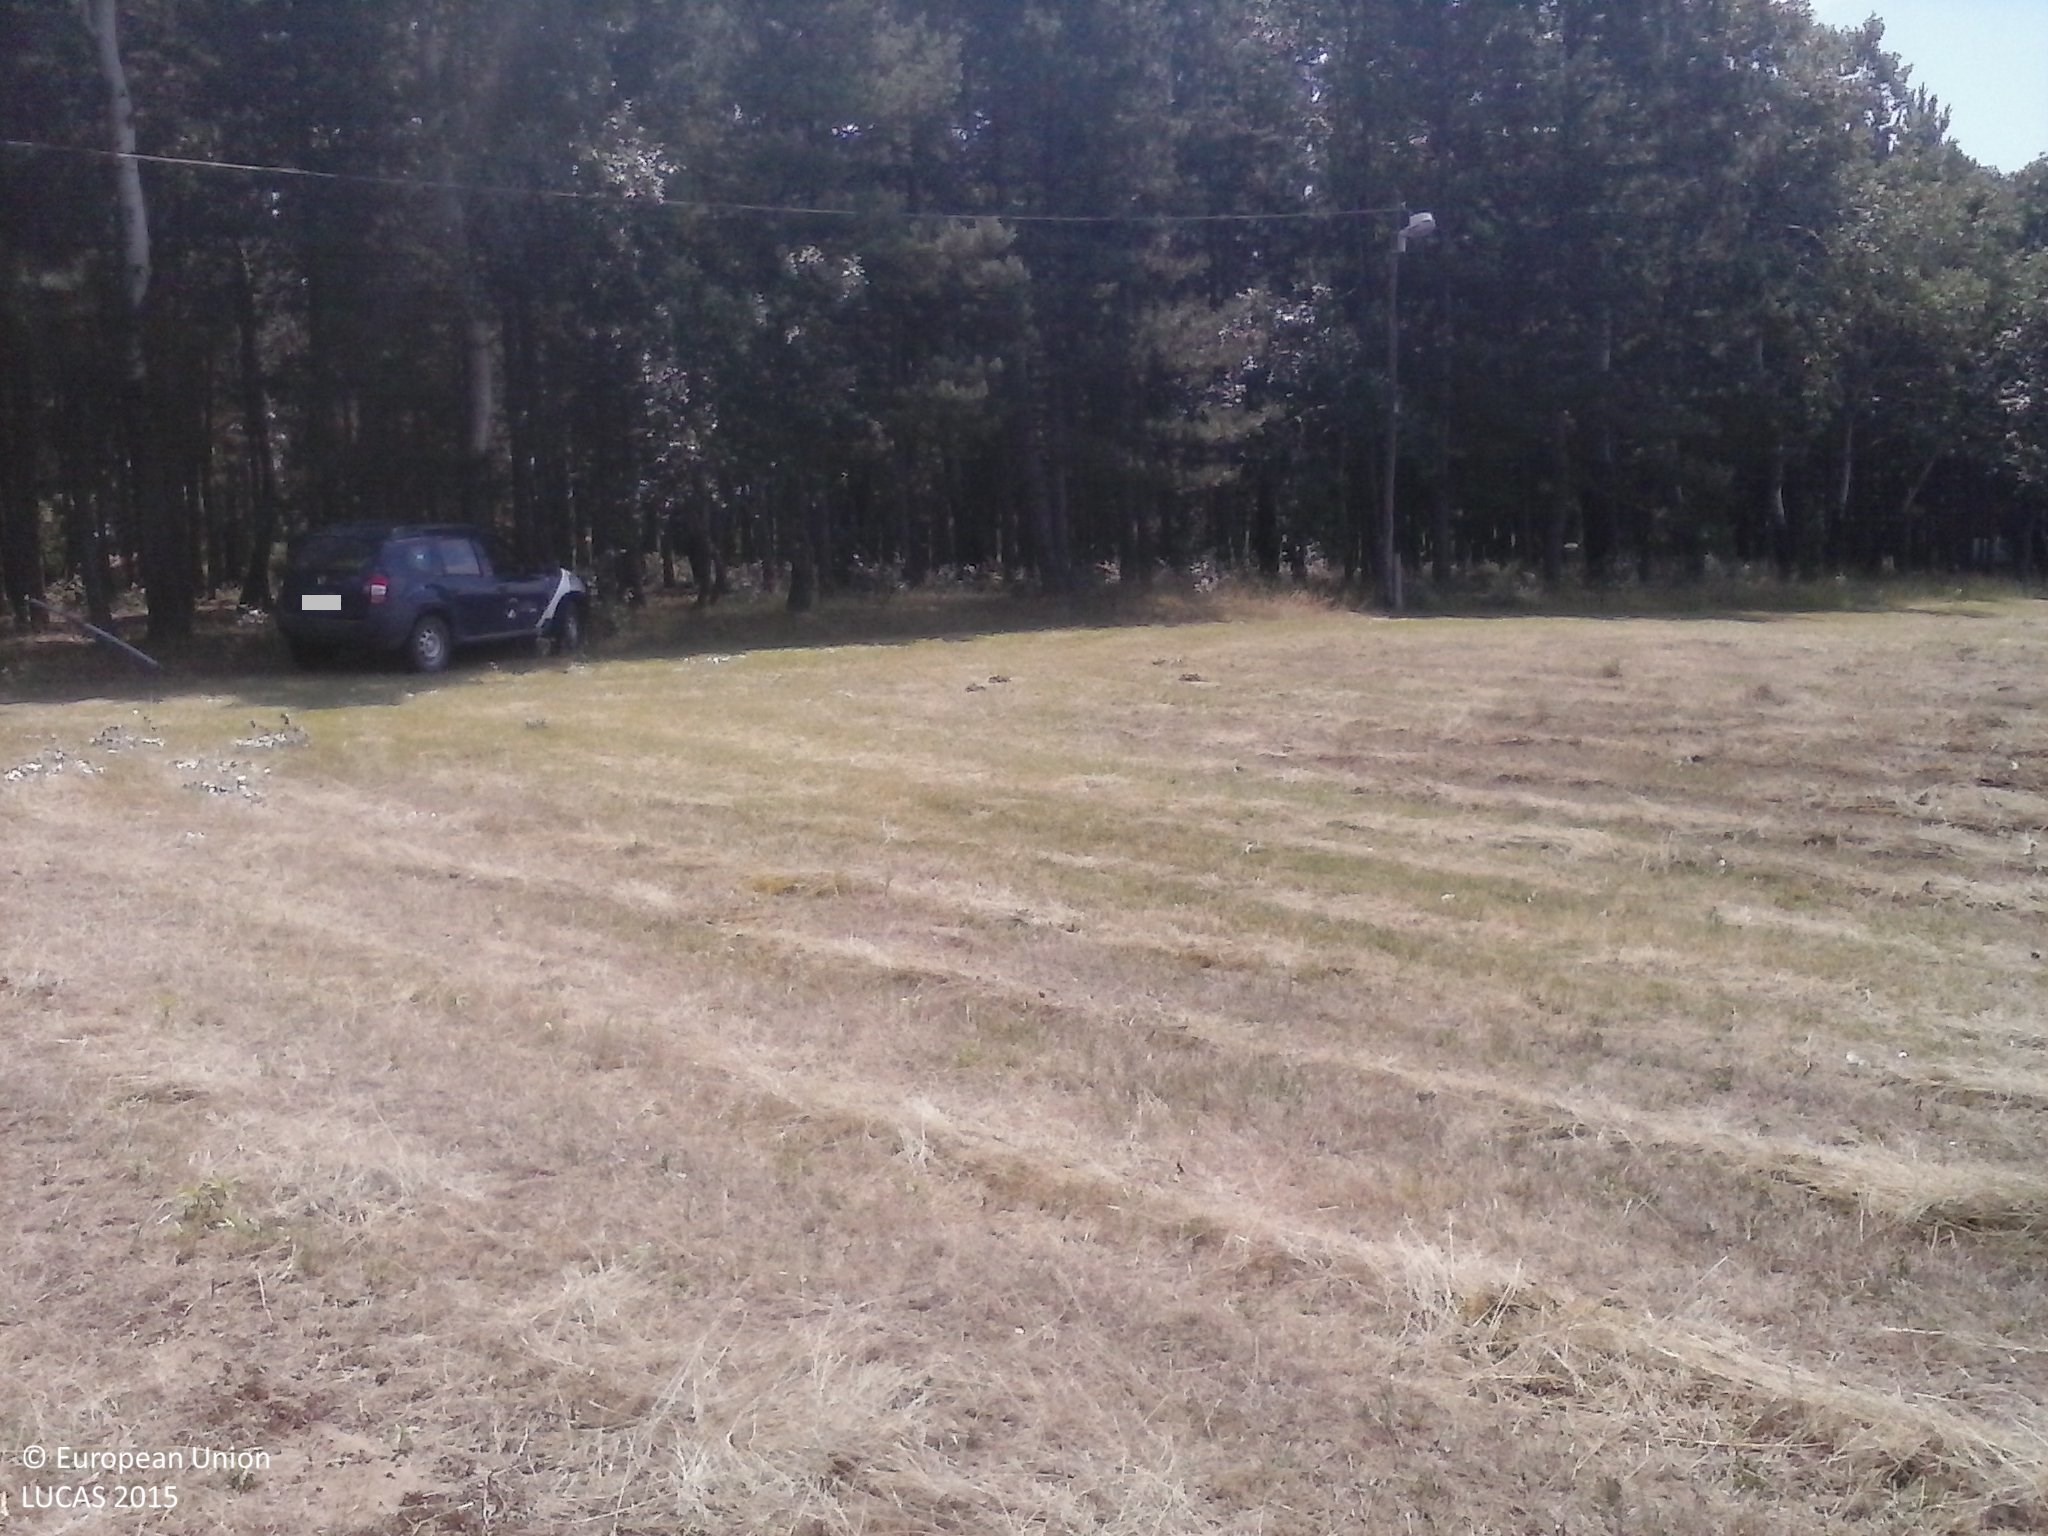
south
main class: Grassland
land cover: Grassland without tree/shrub cover
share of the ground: > 75 %
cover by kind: herbaceous plants 100 %
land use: Agriculture (excluding fallow land and kitchen gardens)
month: July
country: HU
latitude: 46.3587
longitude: 19.5437
